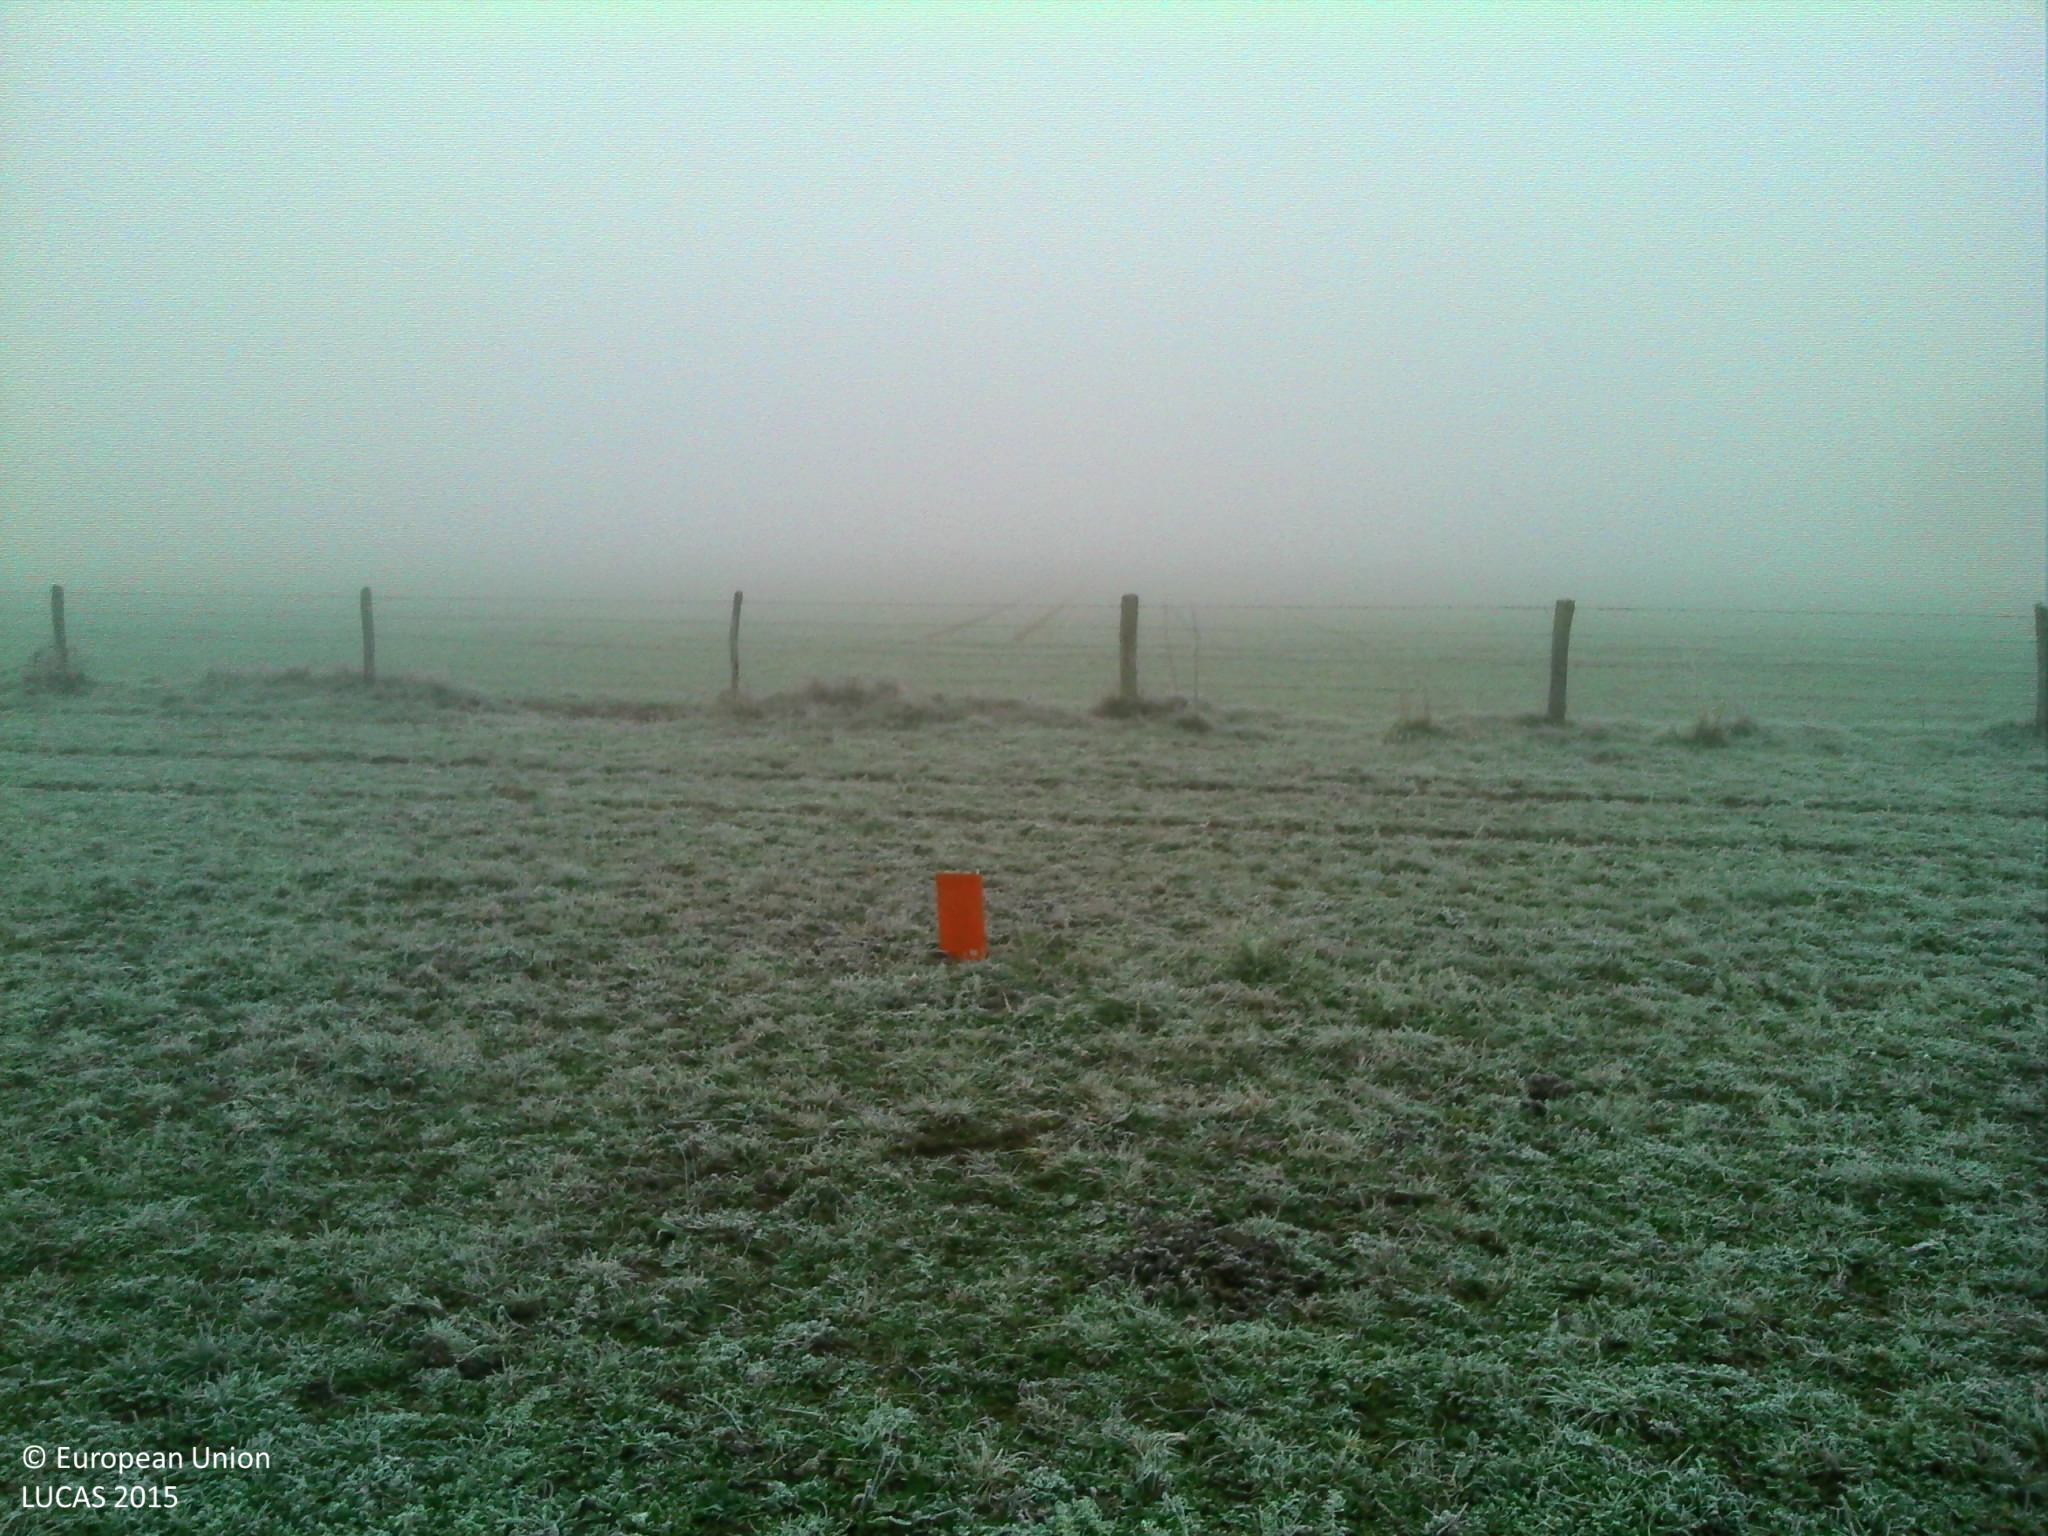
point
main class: Grassland
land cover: Grassland without tree/shrub cover
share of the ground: > 75 %
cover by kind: herbaceous plants 100 %
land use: Agriculture (excluding fallow land and kitchen gardens)
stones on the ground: < 10 %
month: November
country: FR
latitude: 46.5566
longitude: 3.5945
